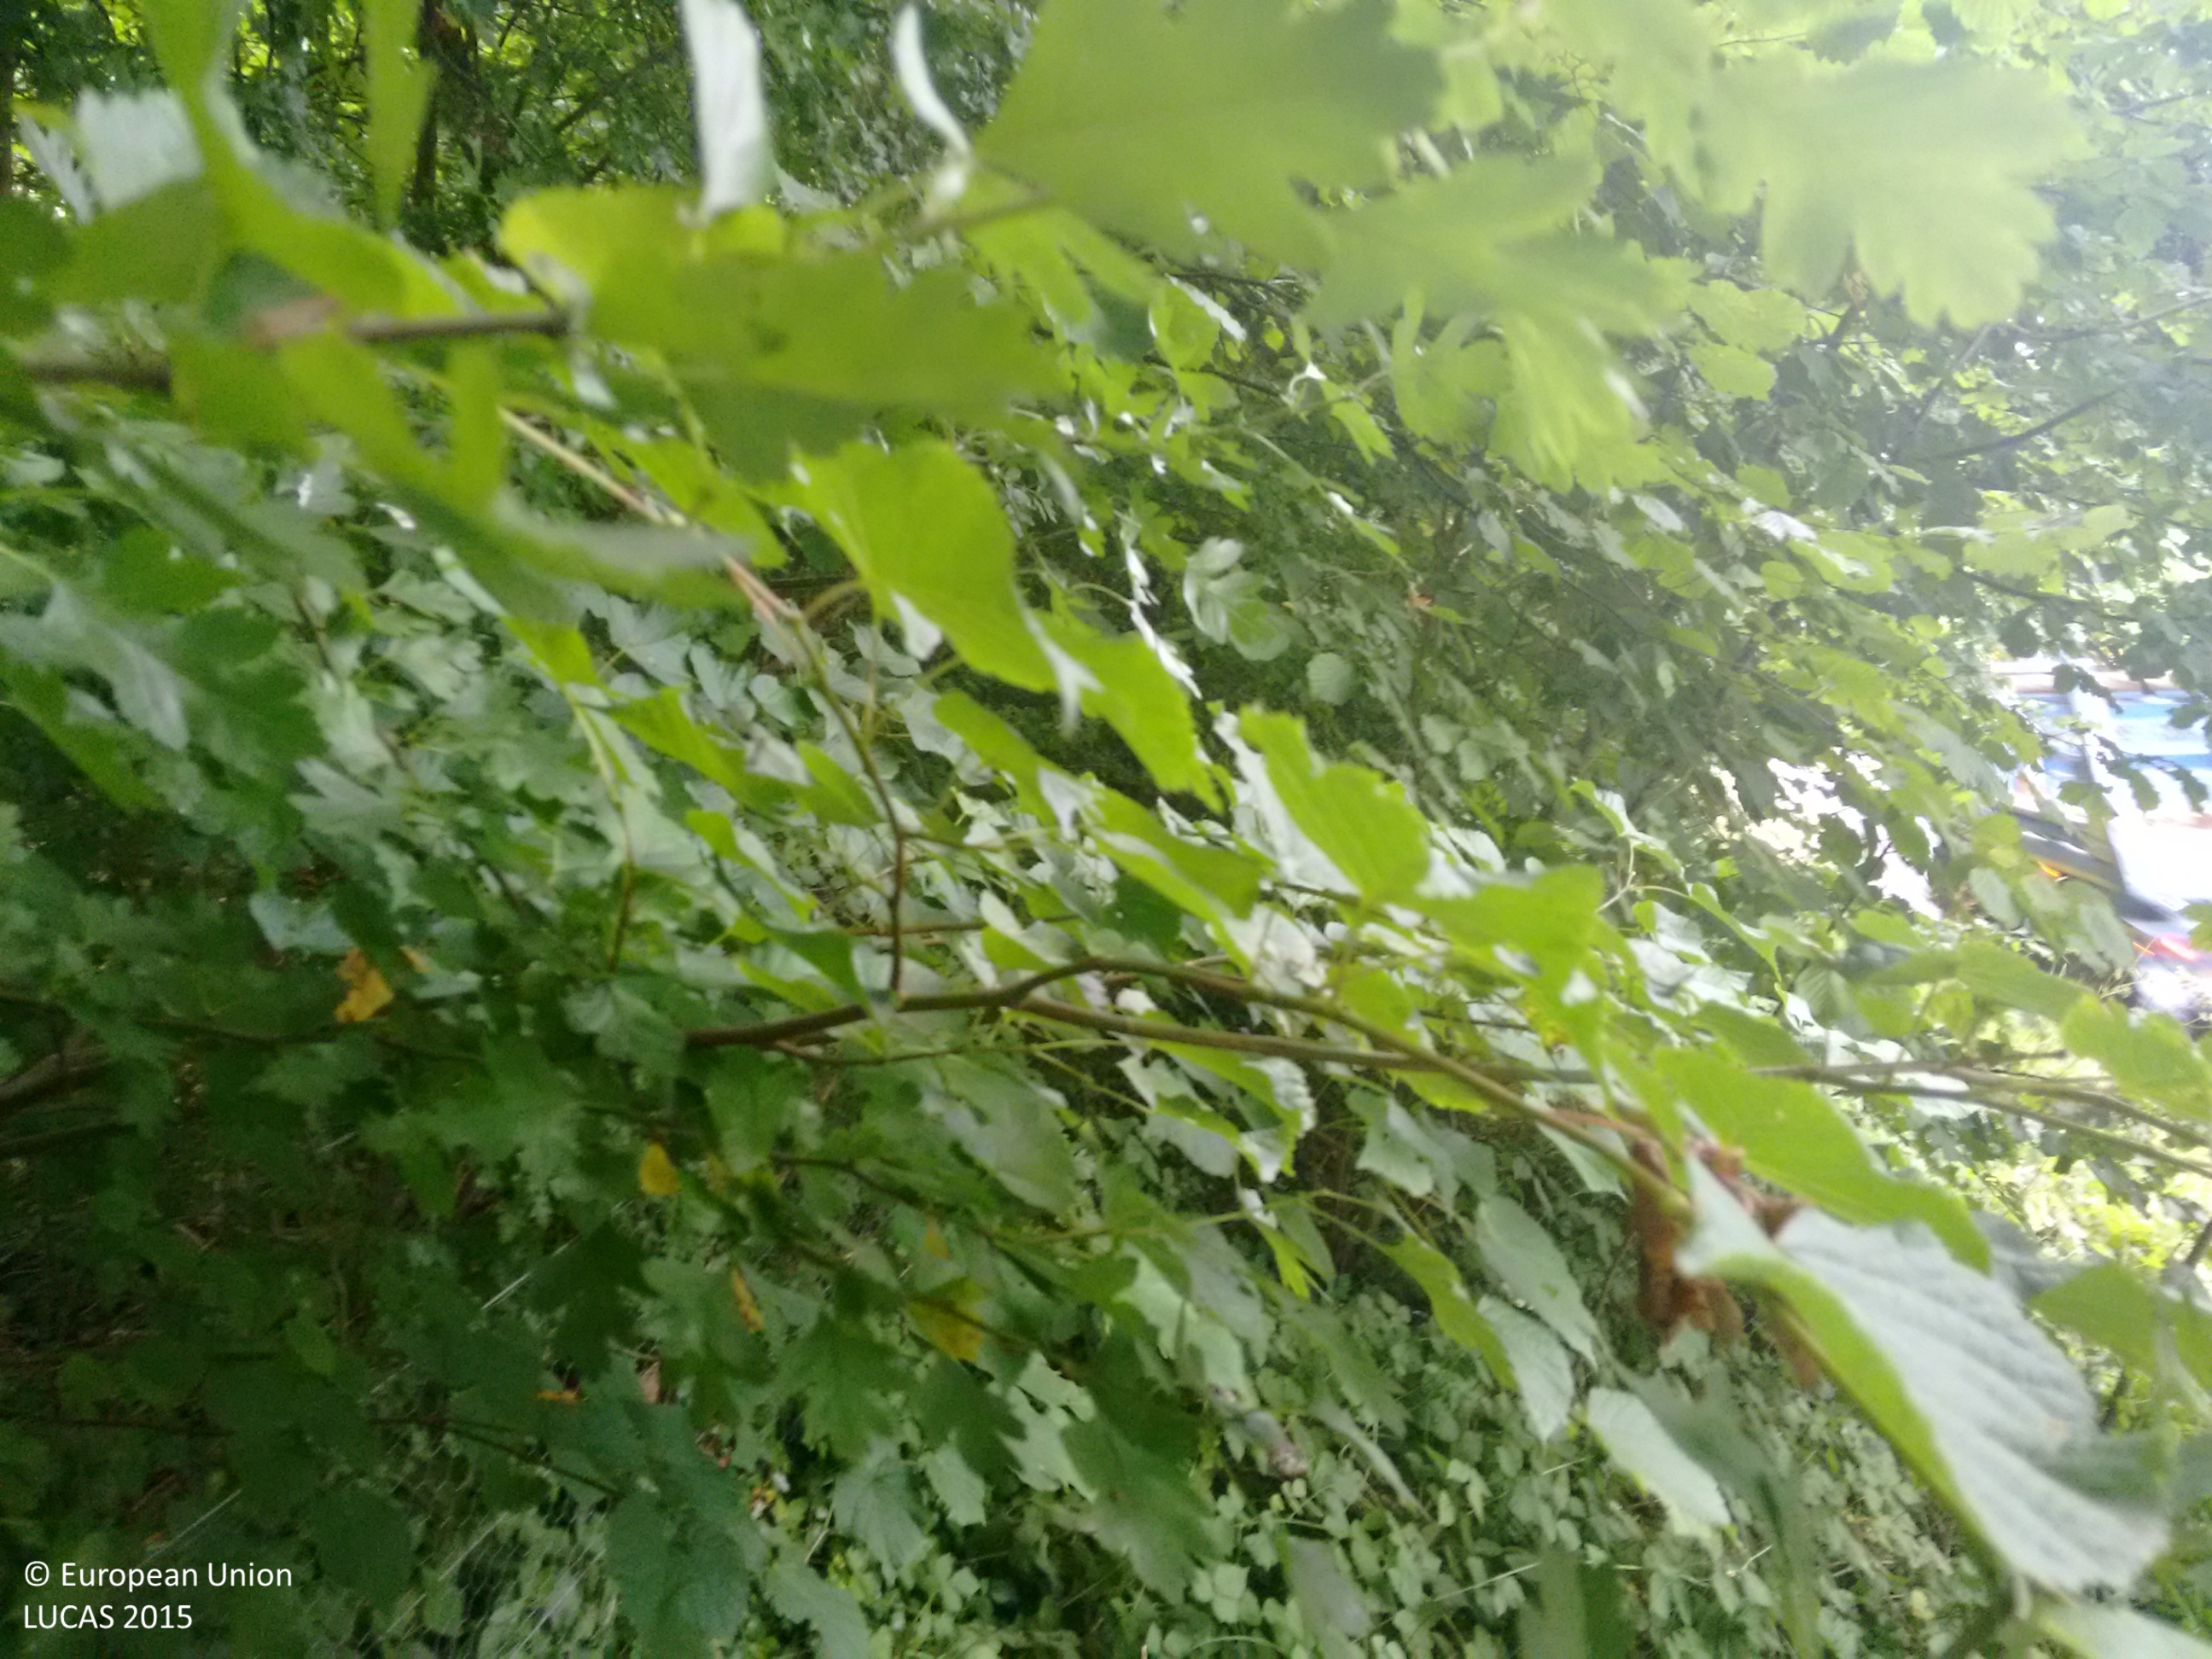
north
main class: Woodland
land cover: Broadleaved woodland
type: mesophytic deciduous forest
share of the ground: > 75 %
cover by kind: broadleaved forest trees 100 %
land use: Forestry
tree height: > 5 m
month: July
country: GB
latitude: 51.0002
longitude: -1.1180
